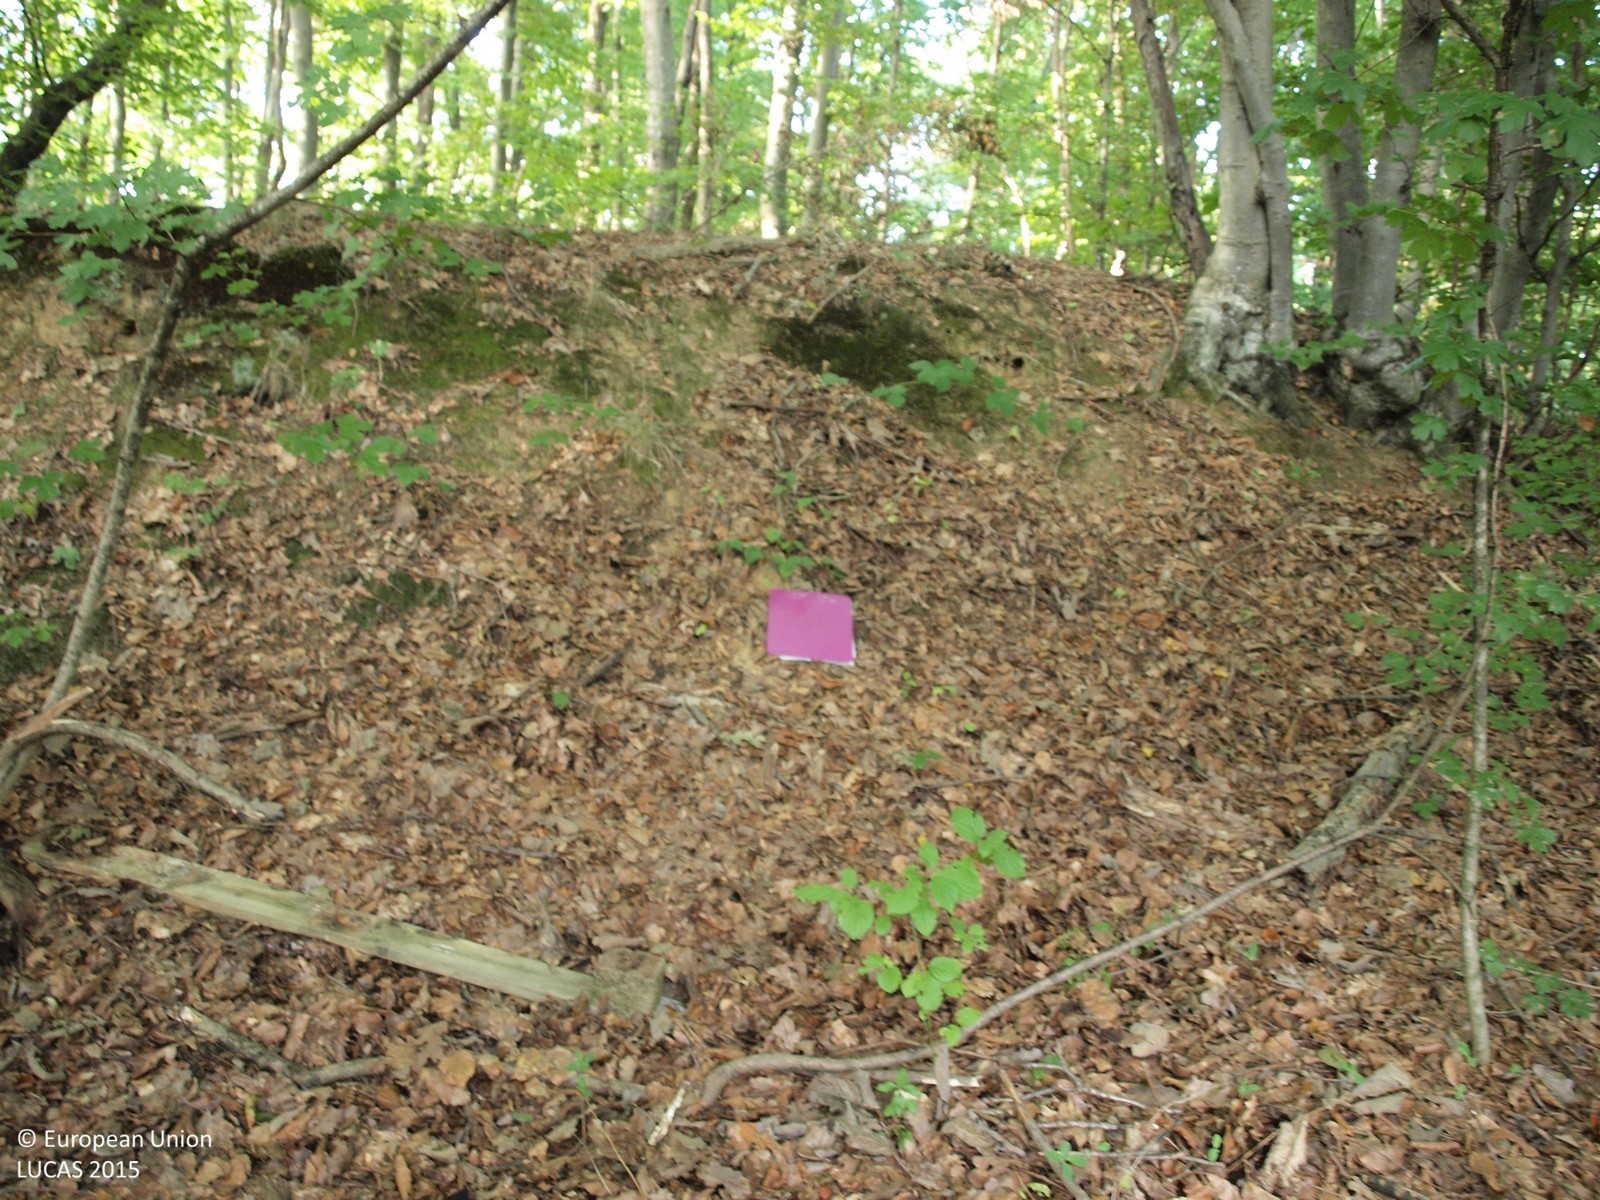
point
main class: Woodland
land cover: Broadleaved woodland
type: mesophytic deciduous forest
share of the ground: > 75 %
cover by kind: broadleaved forest trees 100 %
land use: Forestry
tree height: > 5 m
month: September
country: HR
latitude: 45.6012
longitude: 16.0616
